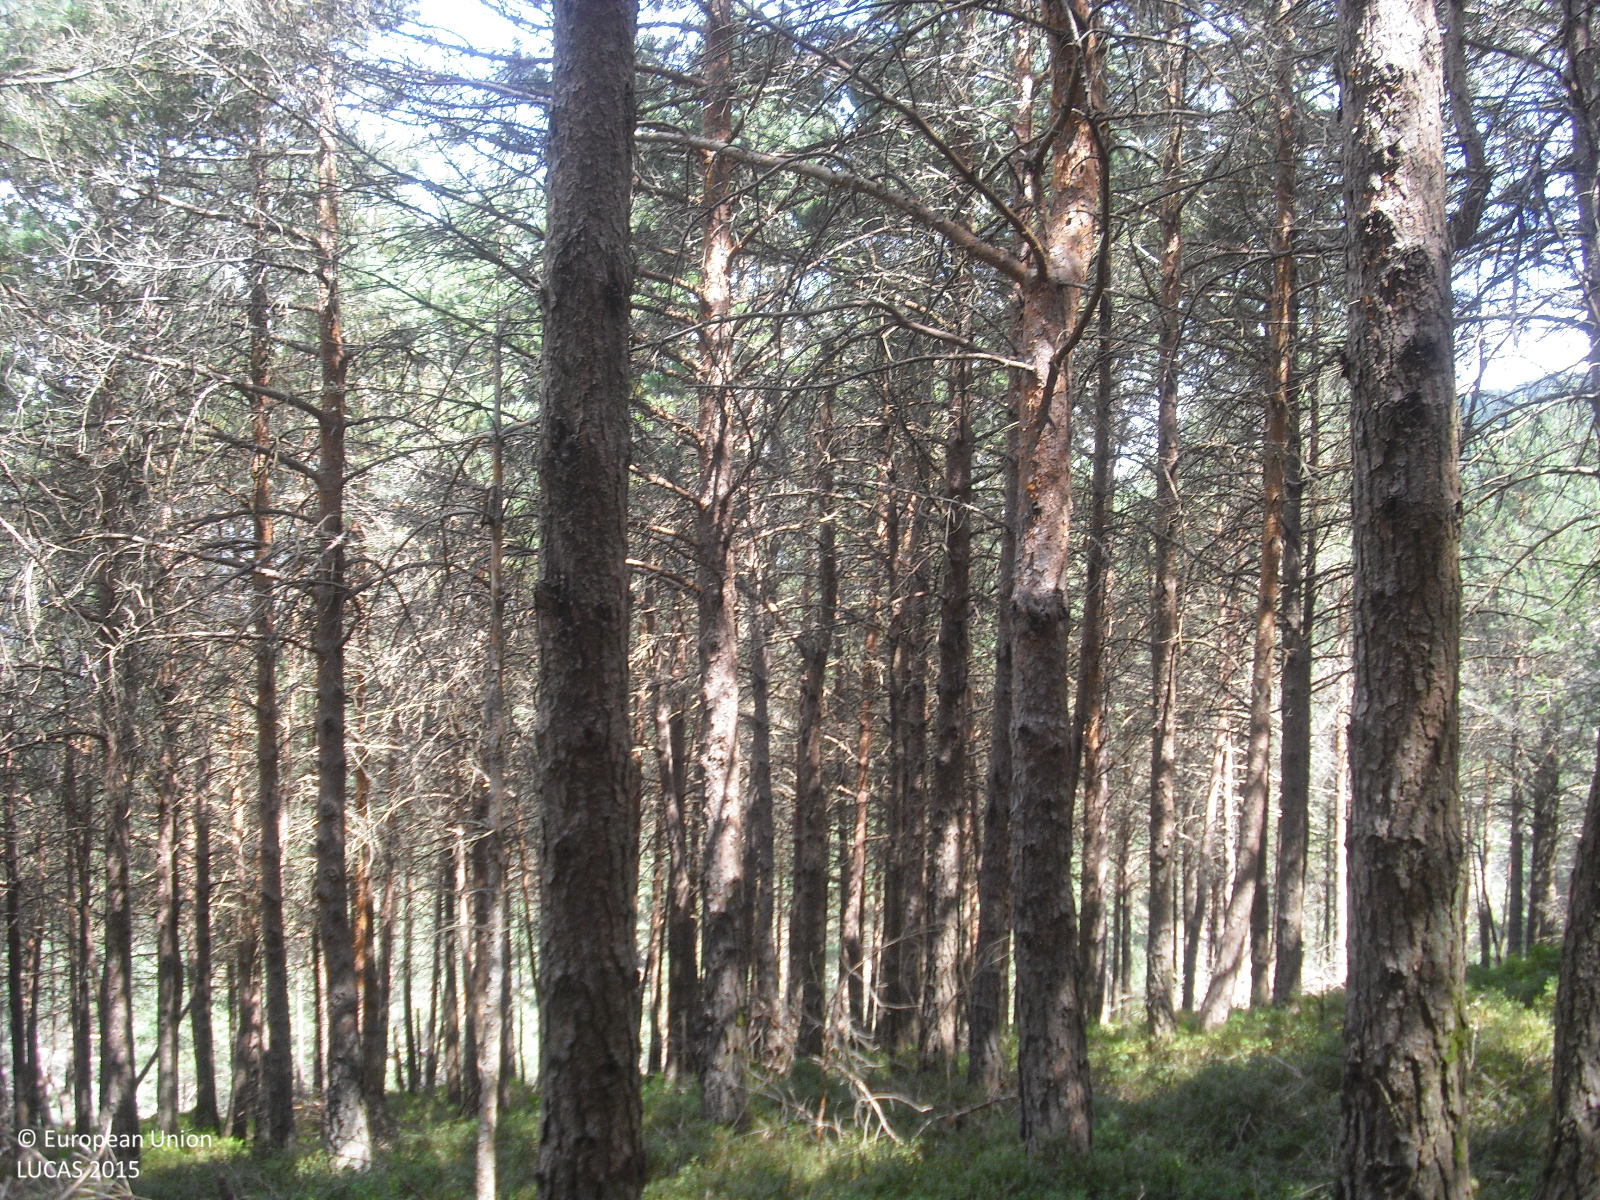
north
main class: Woodland
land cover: Pine dominated coniferous woodland
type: hemiboreal forest and nemoral coniferous forest and mixed broadleaved-coniferous forest
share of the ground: > 75 %
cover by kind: coniferous forest trees 80 %, shrubs 15 %, consolidated bare surface 5 %
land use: Forestry
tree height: > 5 m
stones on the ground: > 50 %
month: July
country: ES
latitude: 42.5517
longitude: -7.1970
